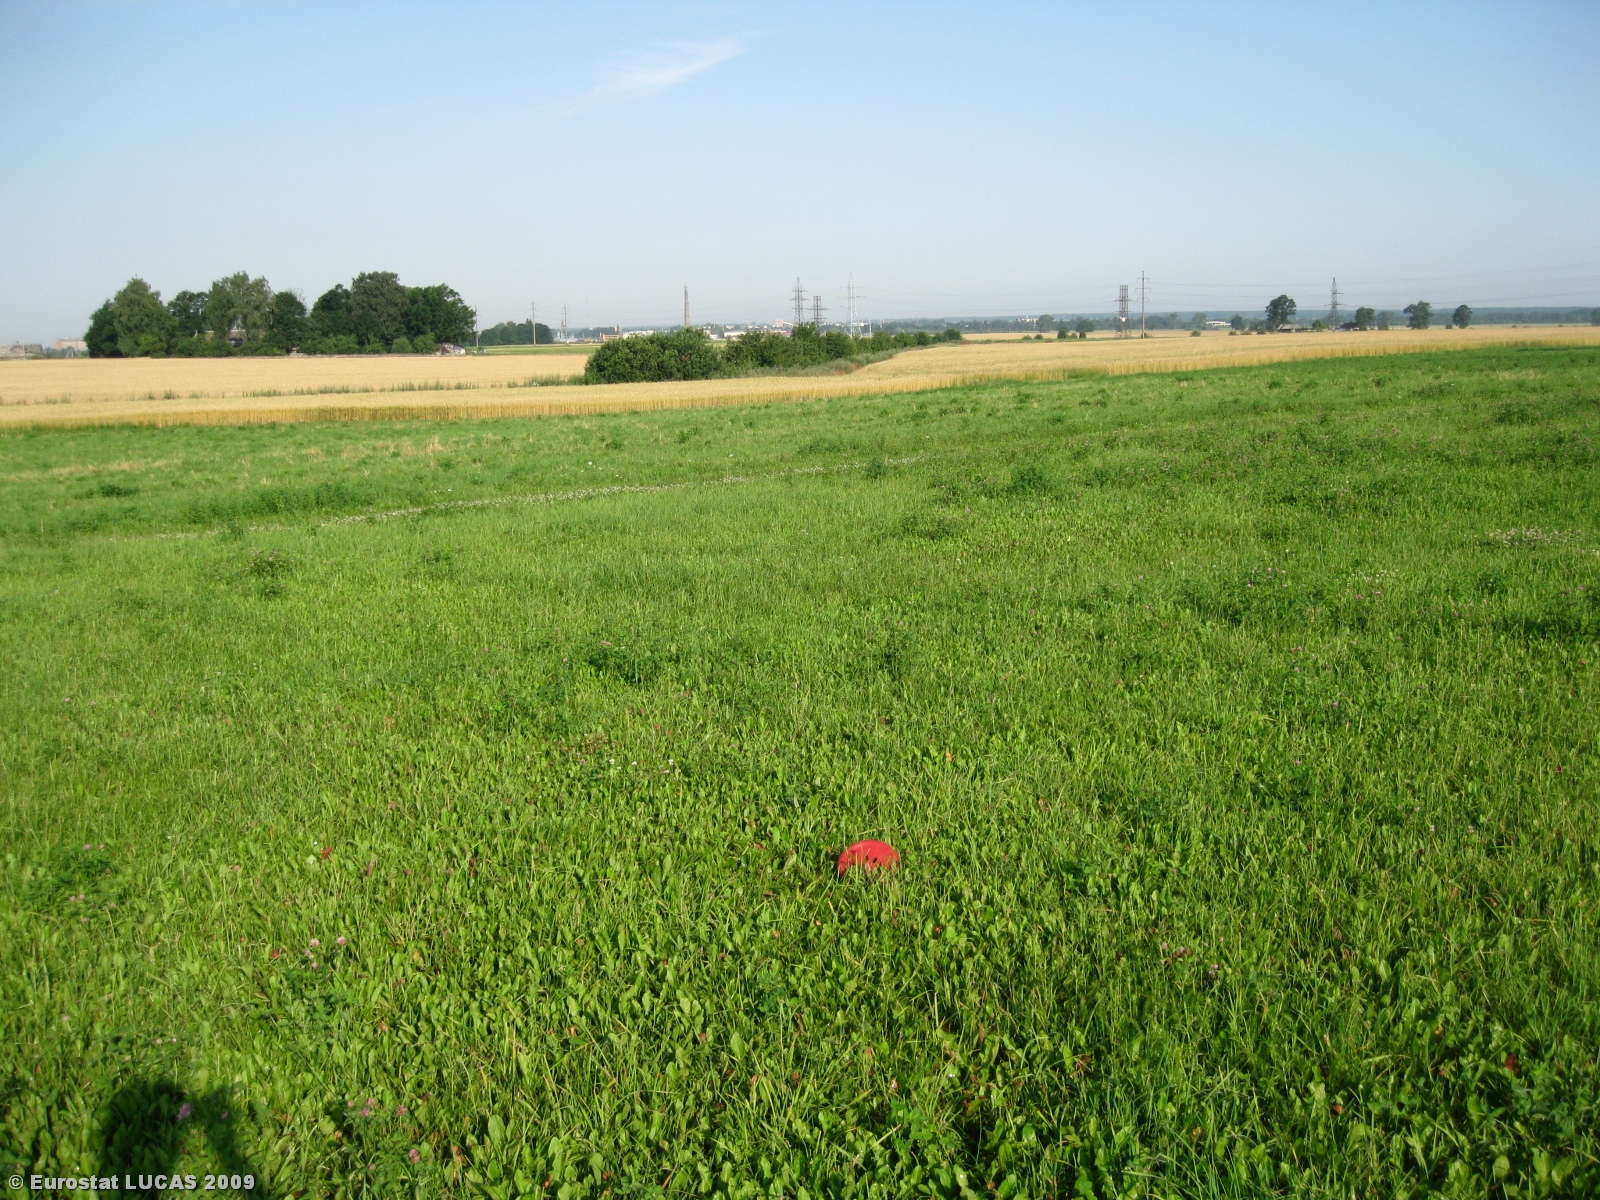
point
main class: Grassland
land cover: Grassland without tree/shrub cover
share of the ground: > 75 %
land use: Agriculture (excluding fallow land and kitchen gardens)
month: July
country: LT
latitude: 54.5651
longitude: 23.4275
